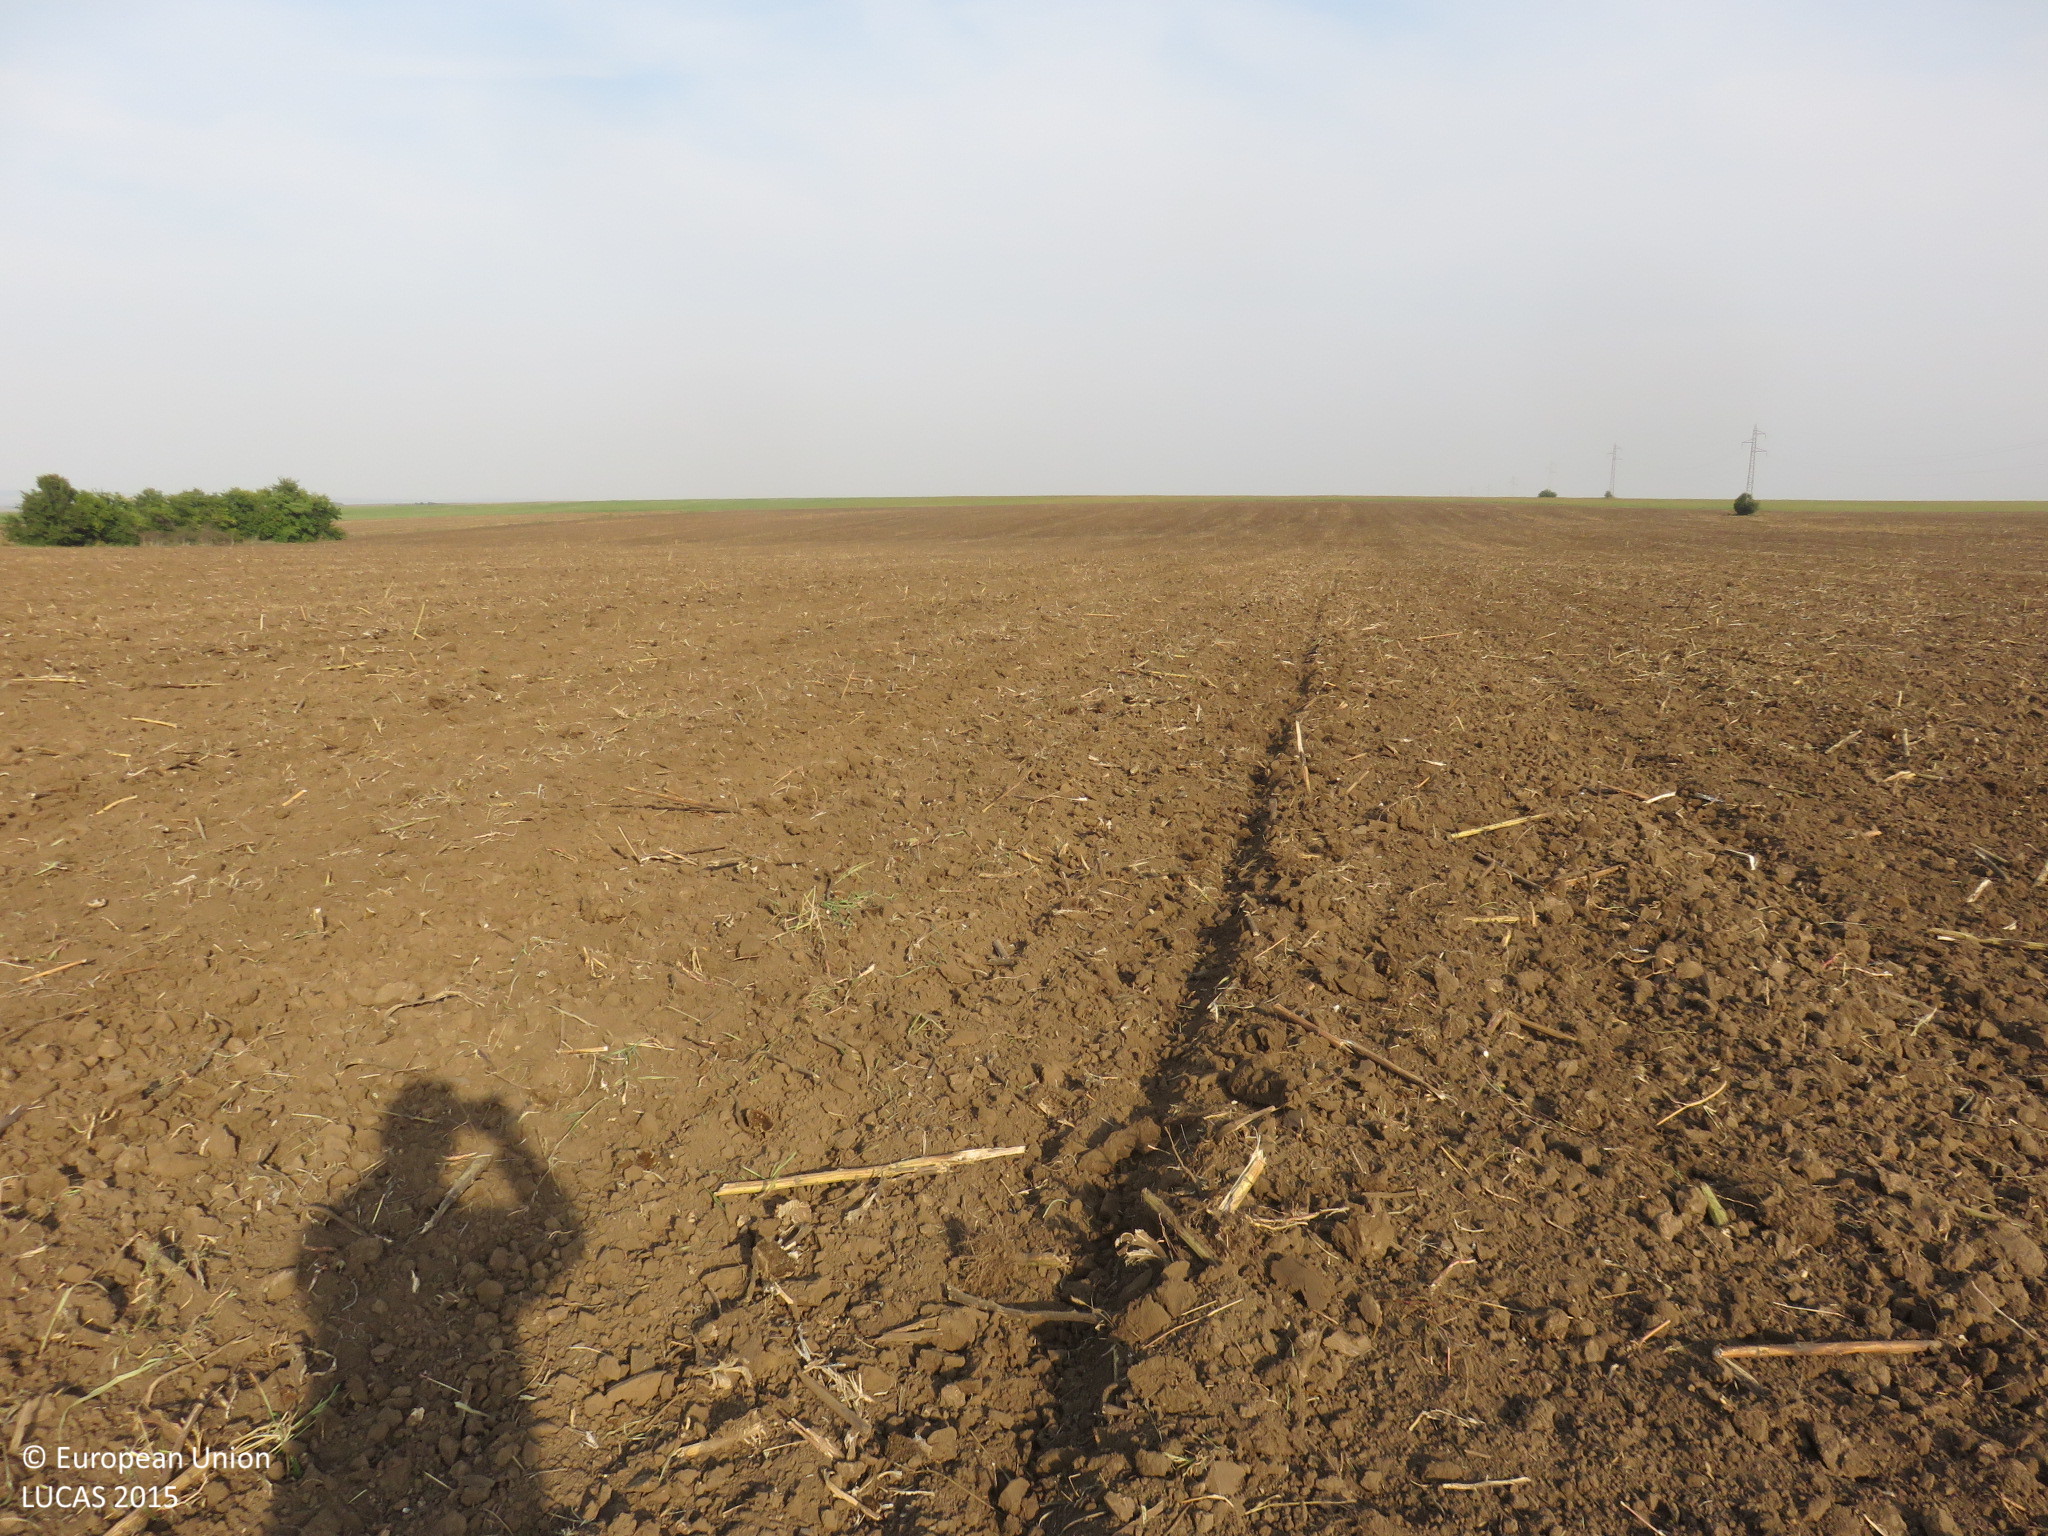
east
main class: Cropland
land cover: Sunflower
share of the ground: < 10 %
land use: Agriculture (excluding fallow land and kitchen gardens)
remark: Harvested field
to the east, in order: Sunflower
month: September
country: BG
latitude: 43.3965
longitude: 24.8961
